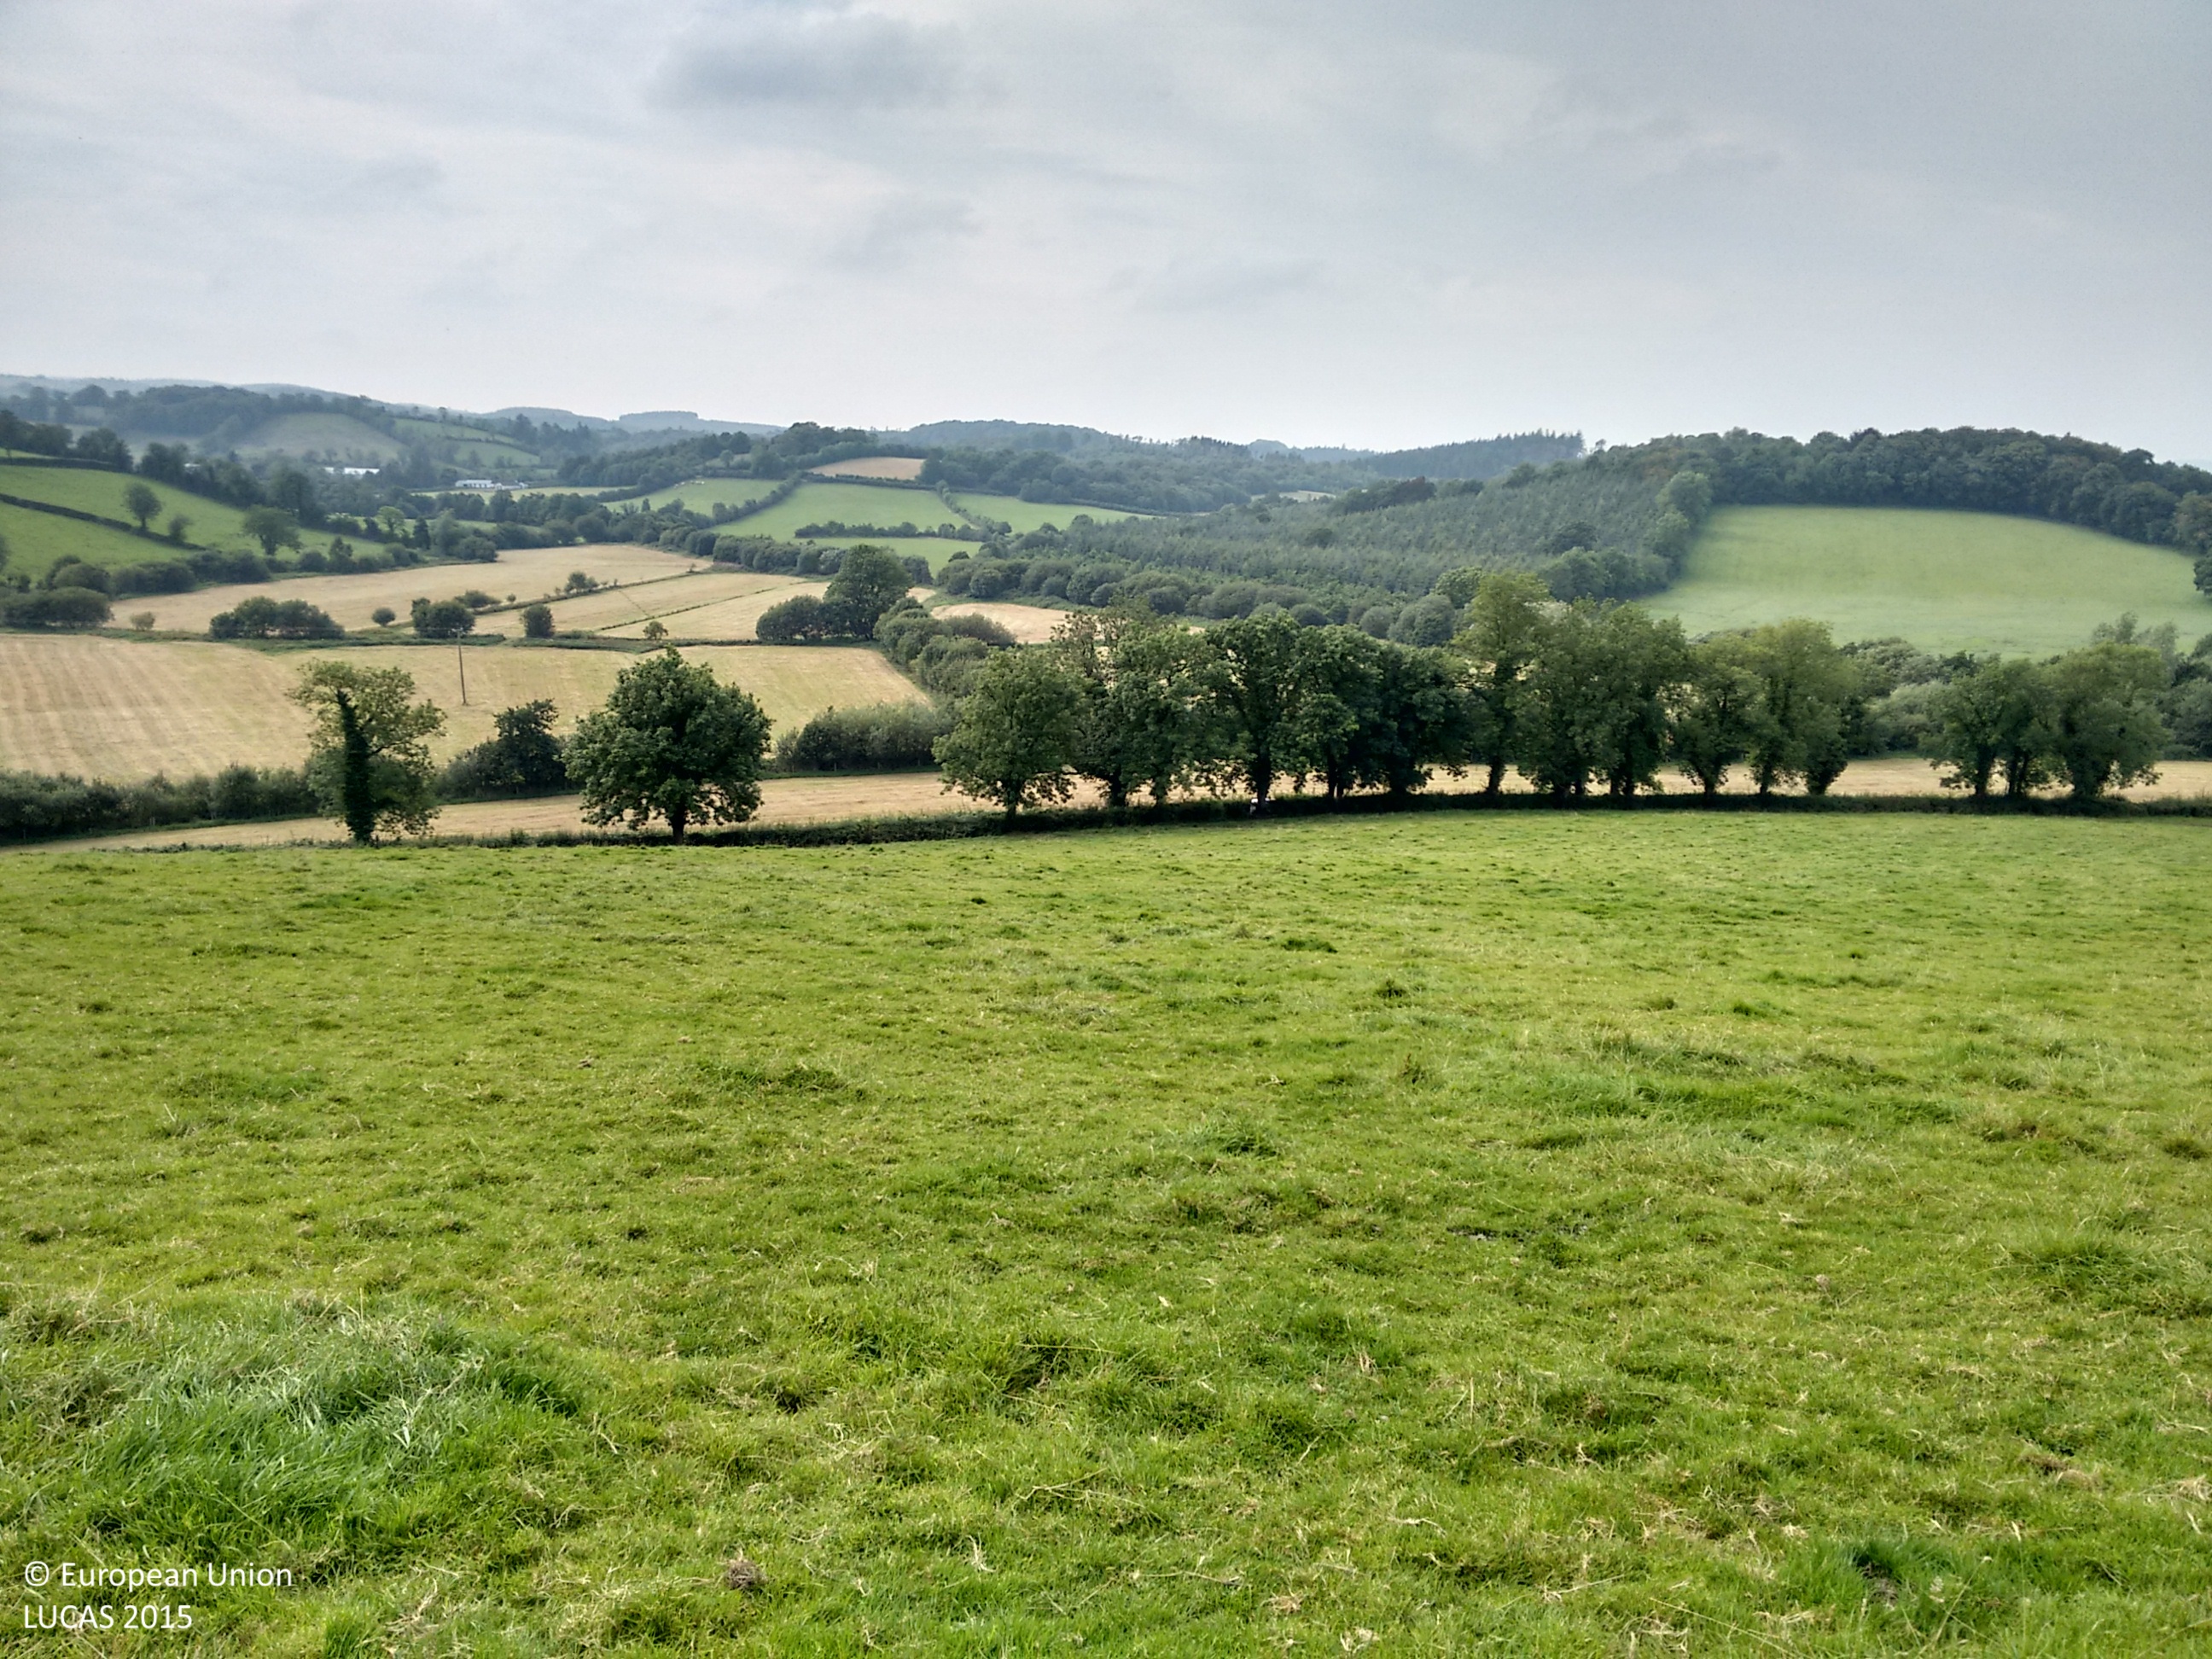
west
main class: Grassland
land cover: Grassland without tree/shrub cover
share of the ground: > 75 %
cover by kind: herbaceous plants 100 %
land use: Agriculture (excluding fallow land and kitchen gardens)
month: September
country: IE
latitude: 54.4124
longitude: -7.0124
